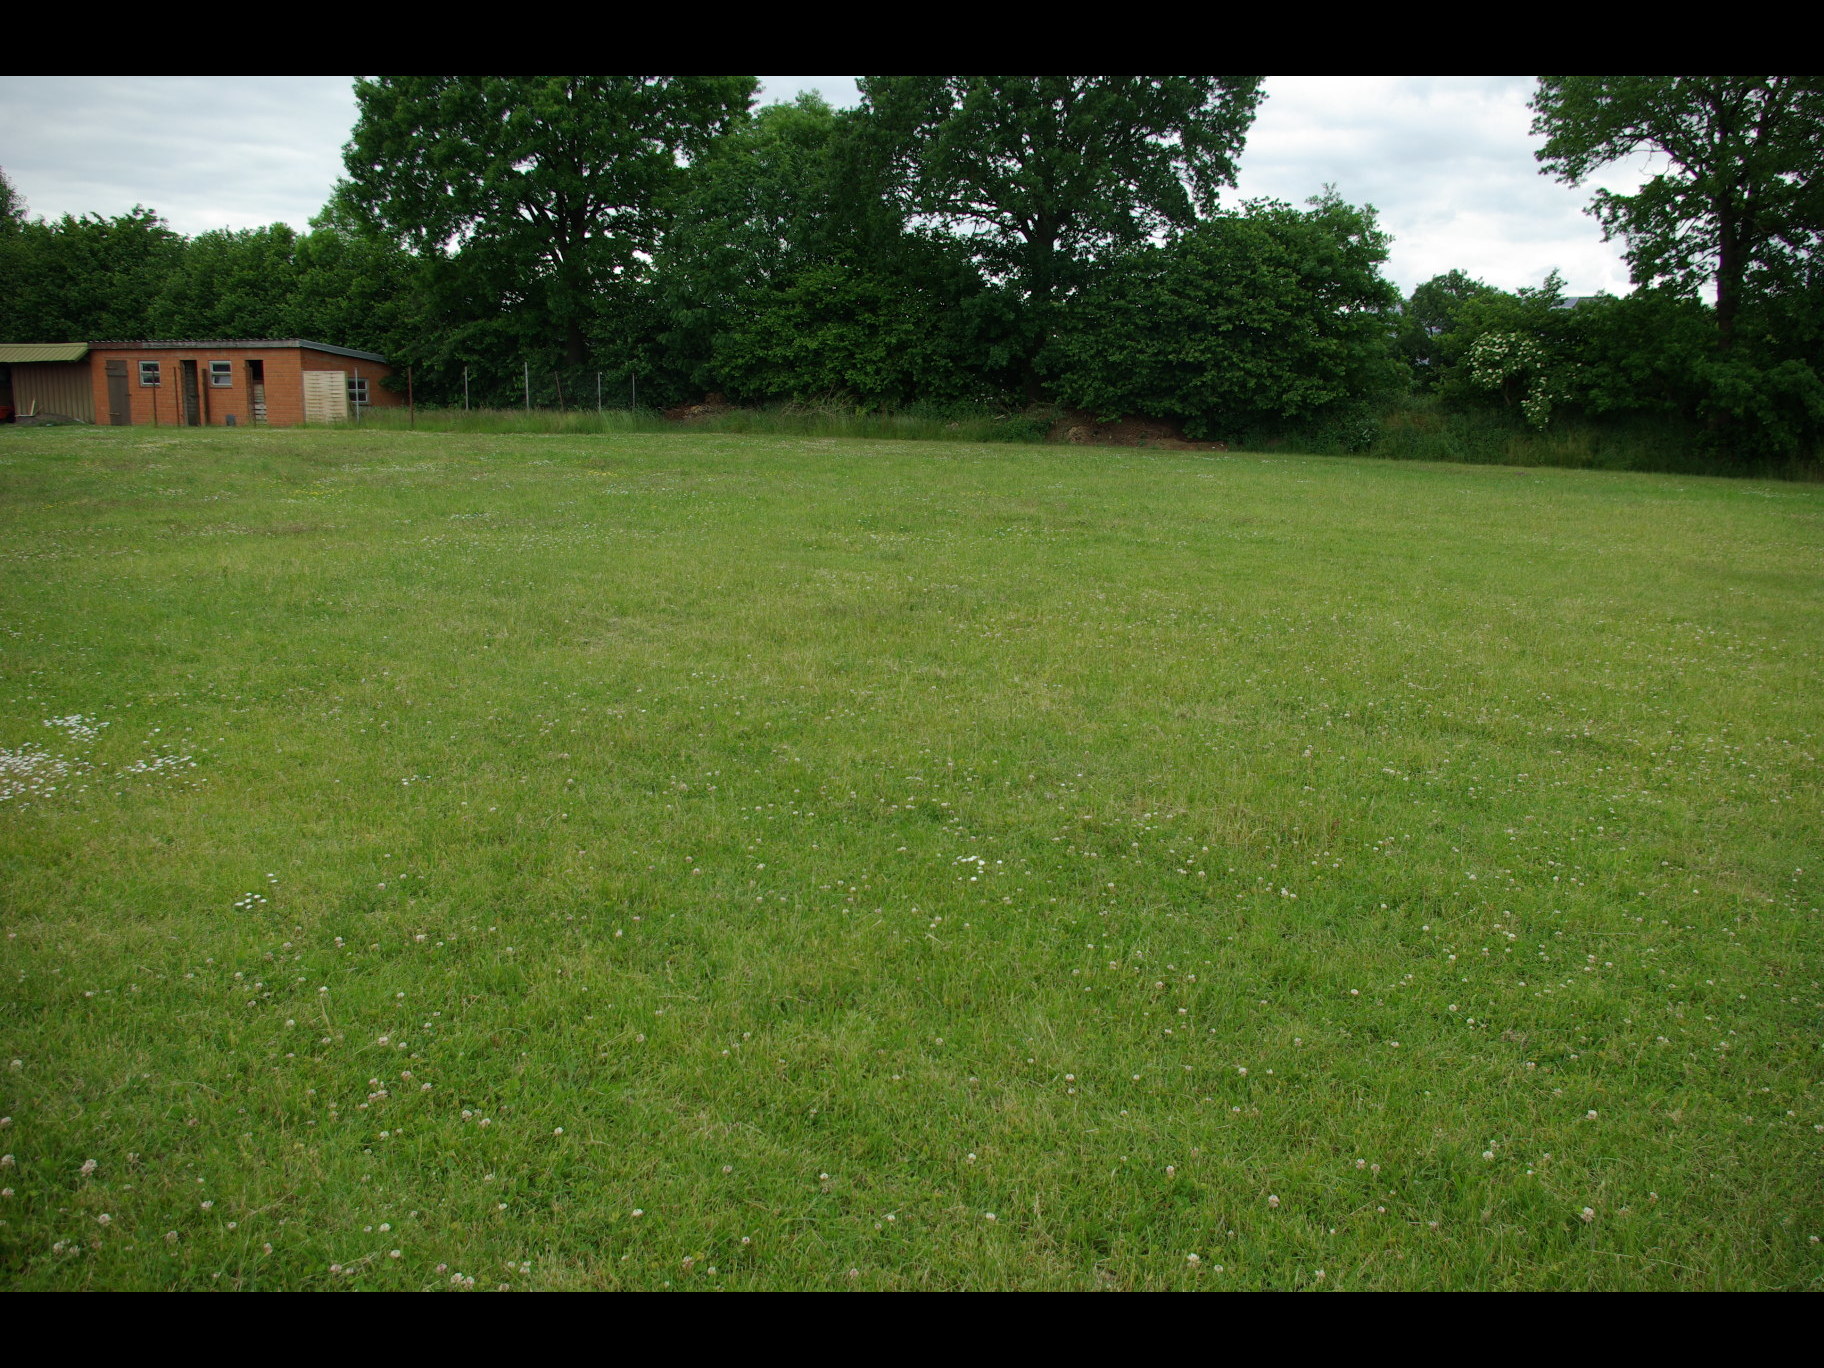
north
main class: Grassland
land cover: Grassland without tree/shrub cover
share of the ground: > 75 %
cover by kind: herbaceous plants 100 %
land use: Agriculture (excluding fallow land and kitchen gardens)
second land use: Amenities, museums, leisure
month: June
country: DE
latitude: 54.1387
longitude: 9.8929
